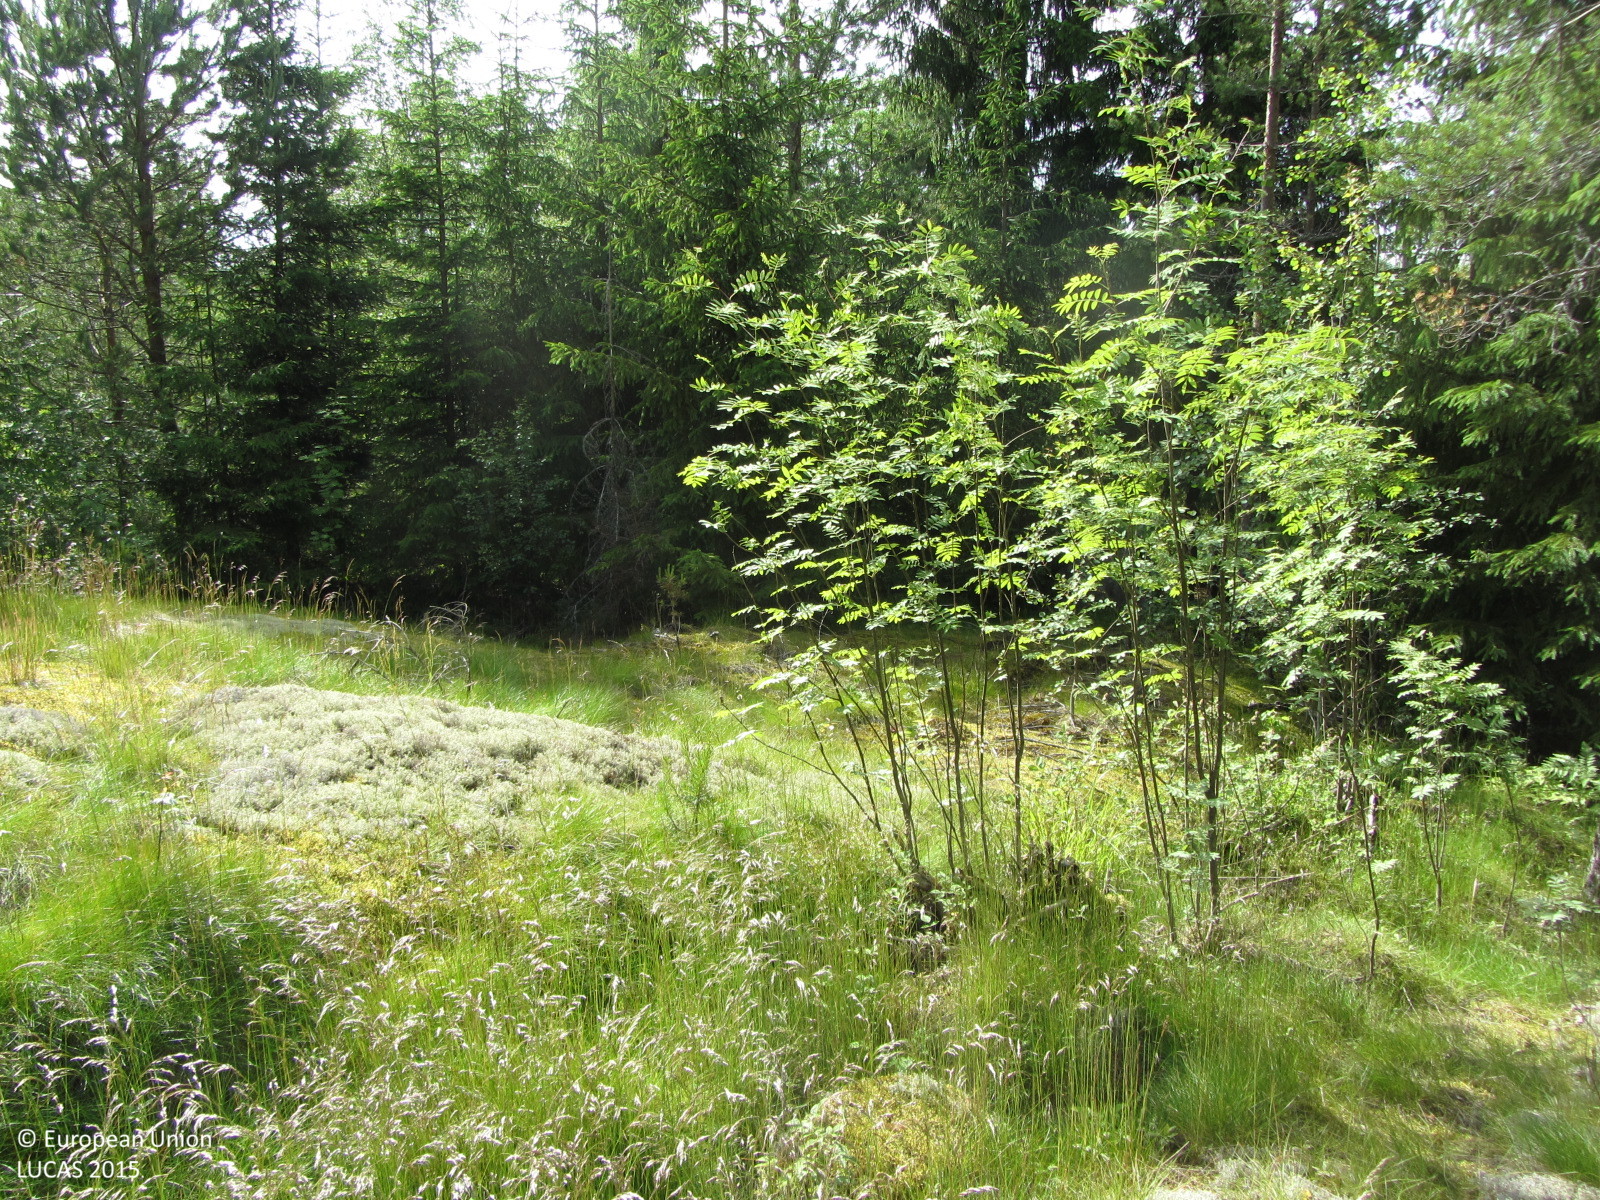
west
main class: Grassland
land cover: Grassland with sparse tree/shrub cover
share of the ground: > 75 %
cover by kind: herbaceous plants 55 %, lichens and mosses 35 %, coniferous forest trees 5 %, shrubs 5 %
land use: Forestry
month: June
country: FI
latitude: 60.2861
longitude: 23.4164
